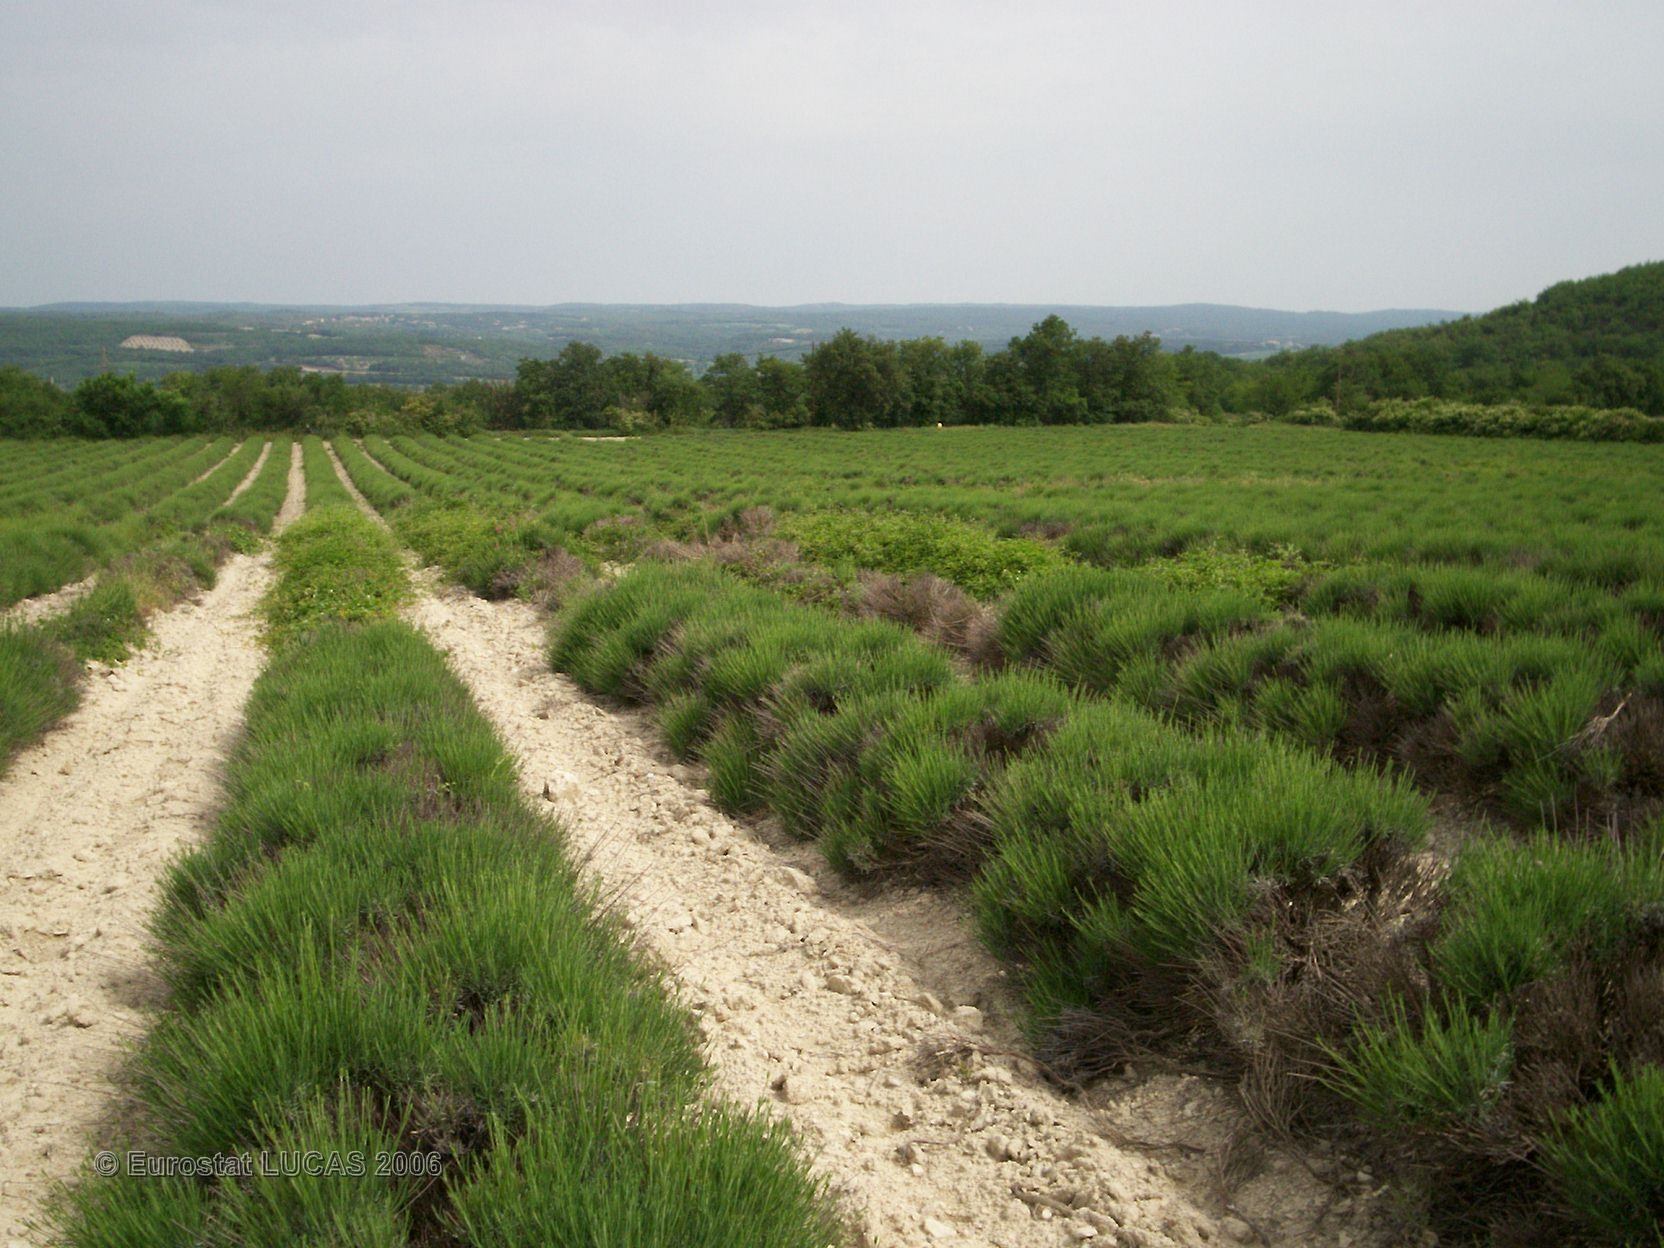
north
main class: Cropland
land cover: Permanent industrial crops
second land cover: Bare land
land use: Agriculture (excluding fallow land and kitchen gardens)
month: May
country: FR
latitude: 44.4032
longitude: 4.8466
